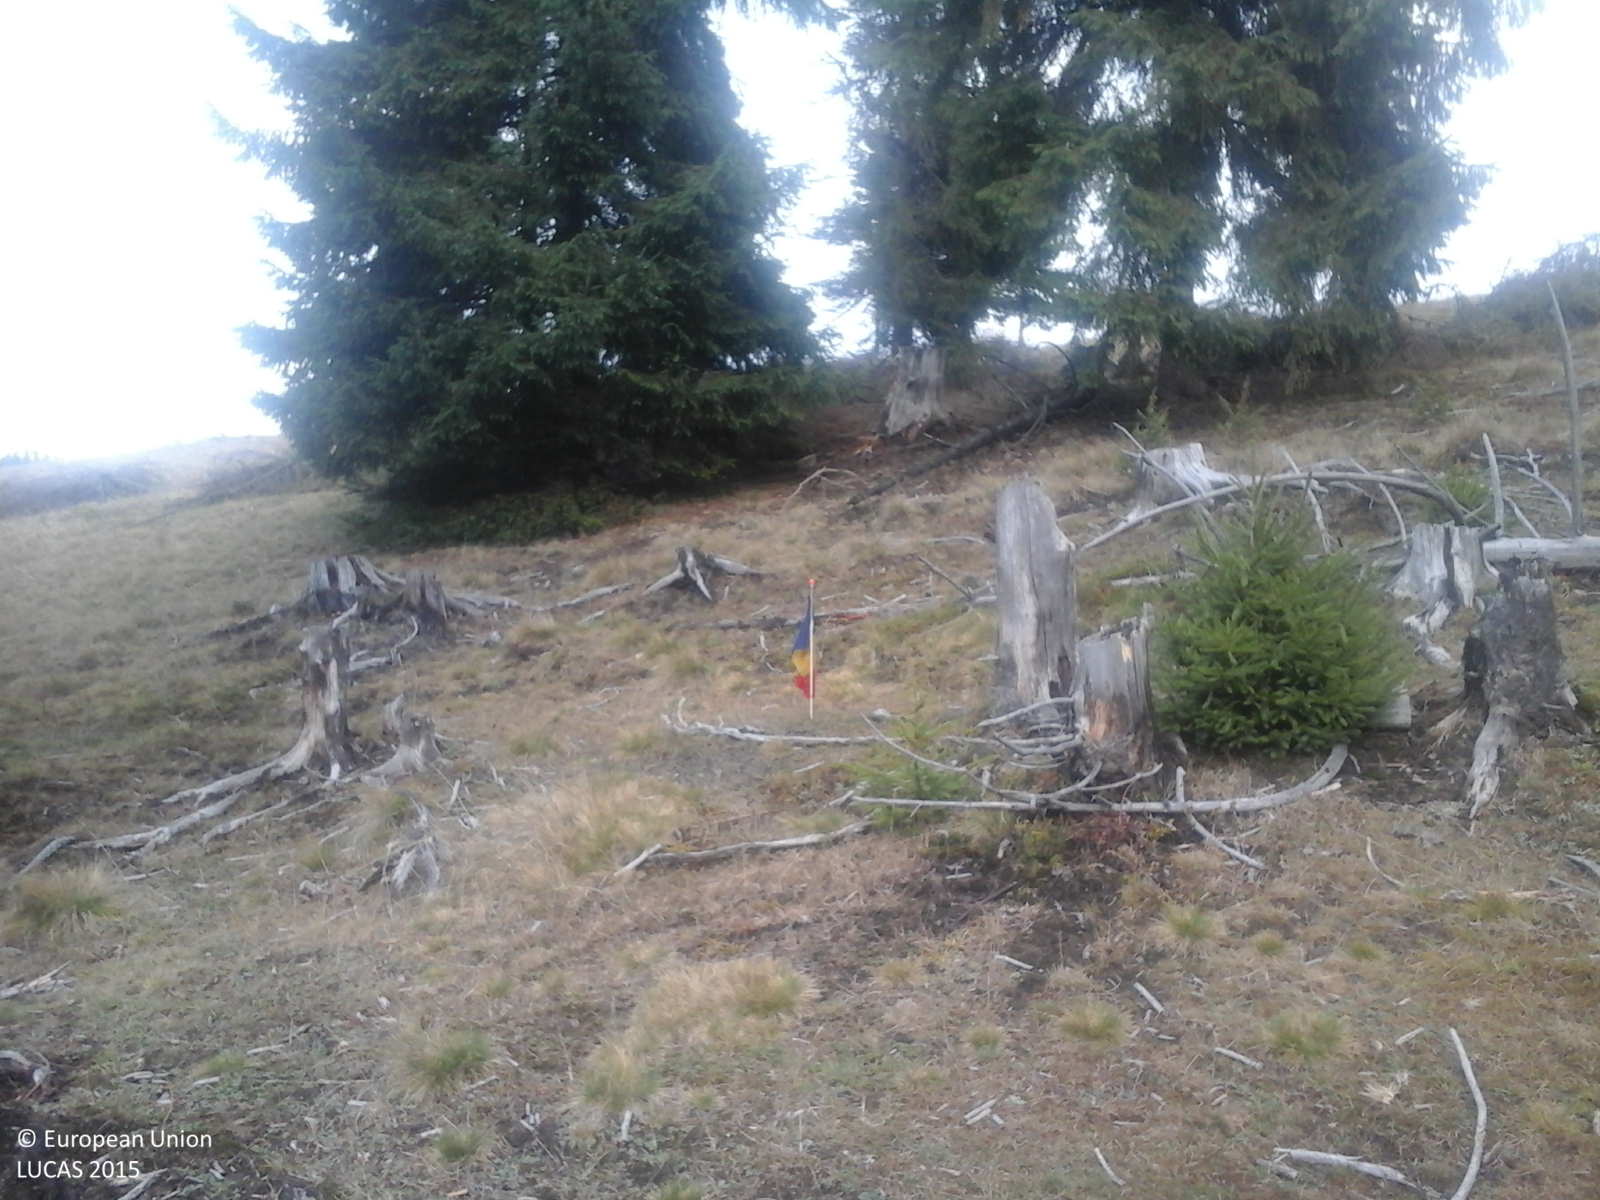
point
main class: Grassland
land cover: Grassland with sparse tree/shrub cover
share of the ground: > 75 %
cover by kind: herbaceous plants 85 %, shrubs 10 %, broadleaved forest trees 5 %
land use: Forestry
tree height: < 5 m
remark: Clear cut
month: October
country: RO
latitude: 46.5038
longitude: 26.0597
